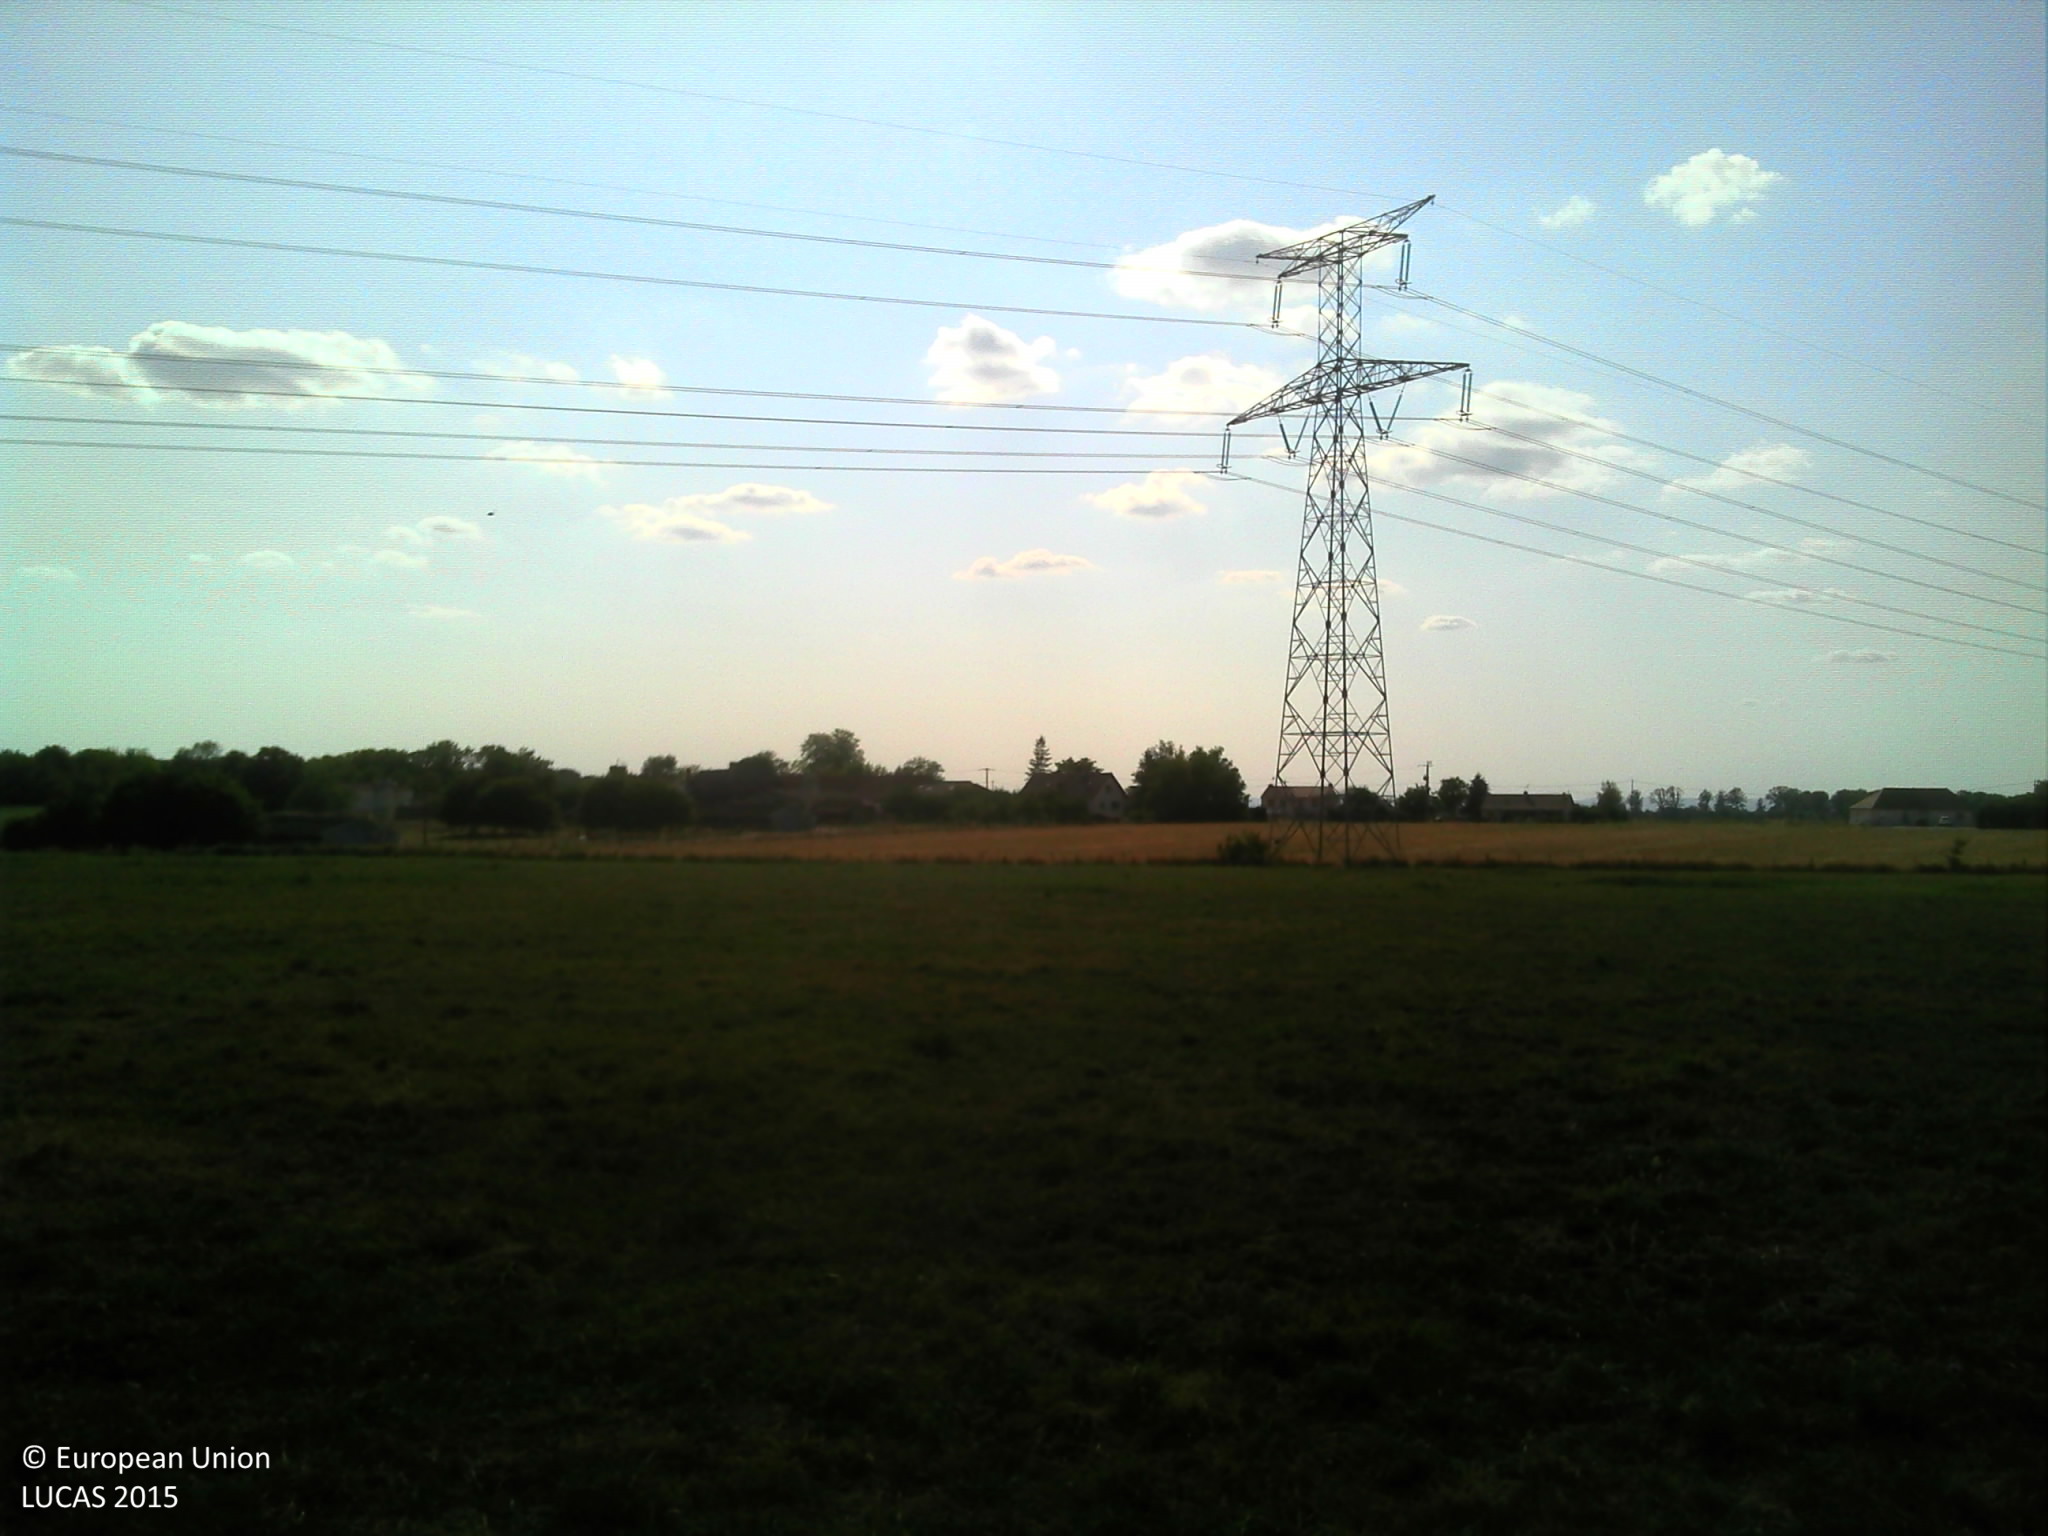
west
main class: Grassland
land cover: Grassland without tree/shrub cover
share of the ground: > 75 %
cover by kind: herbaceous plants 100 %
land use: Agriculture (excluding fallow land and kitchen gardens)
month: July
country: FR
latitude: 46.8516
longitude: 5.0834
